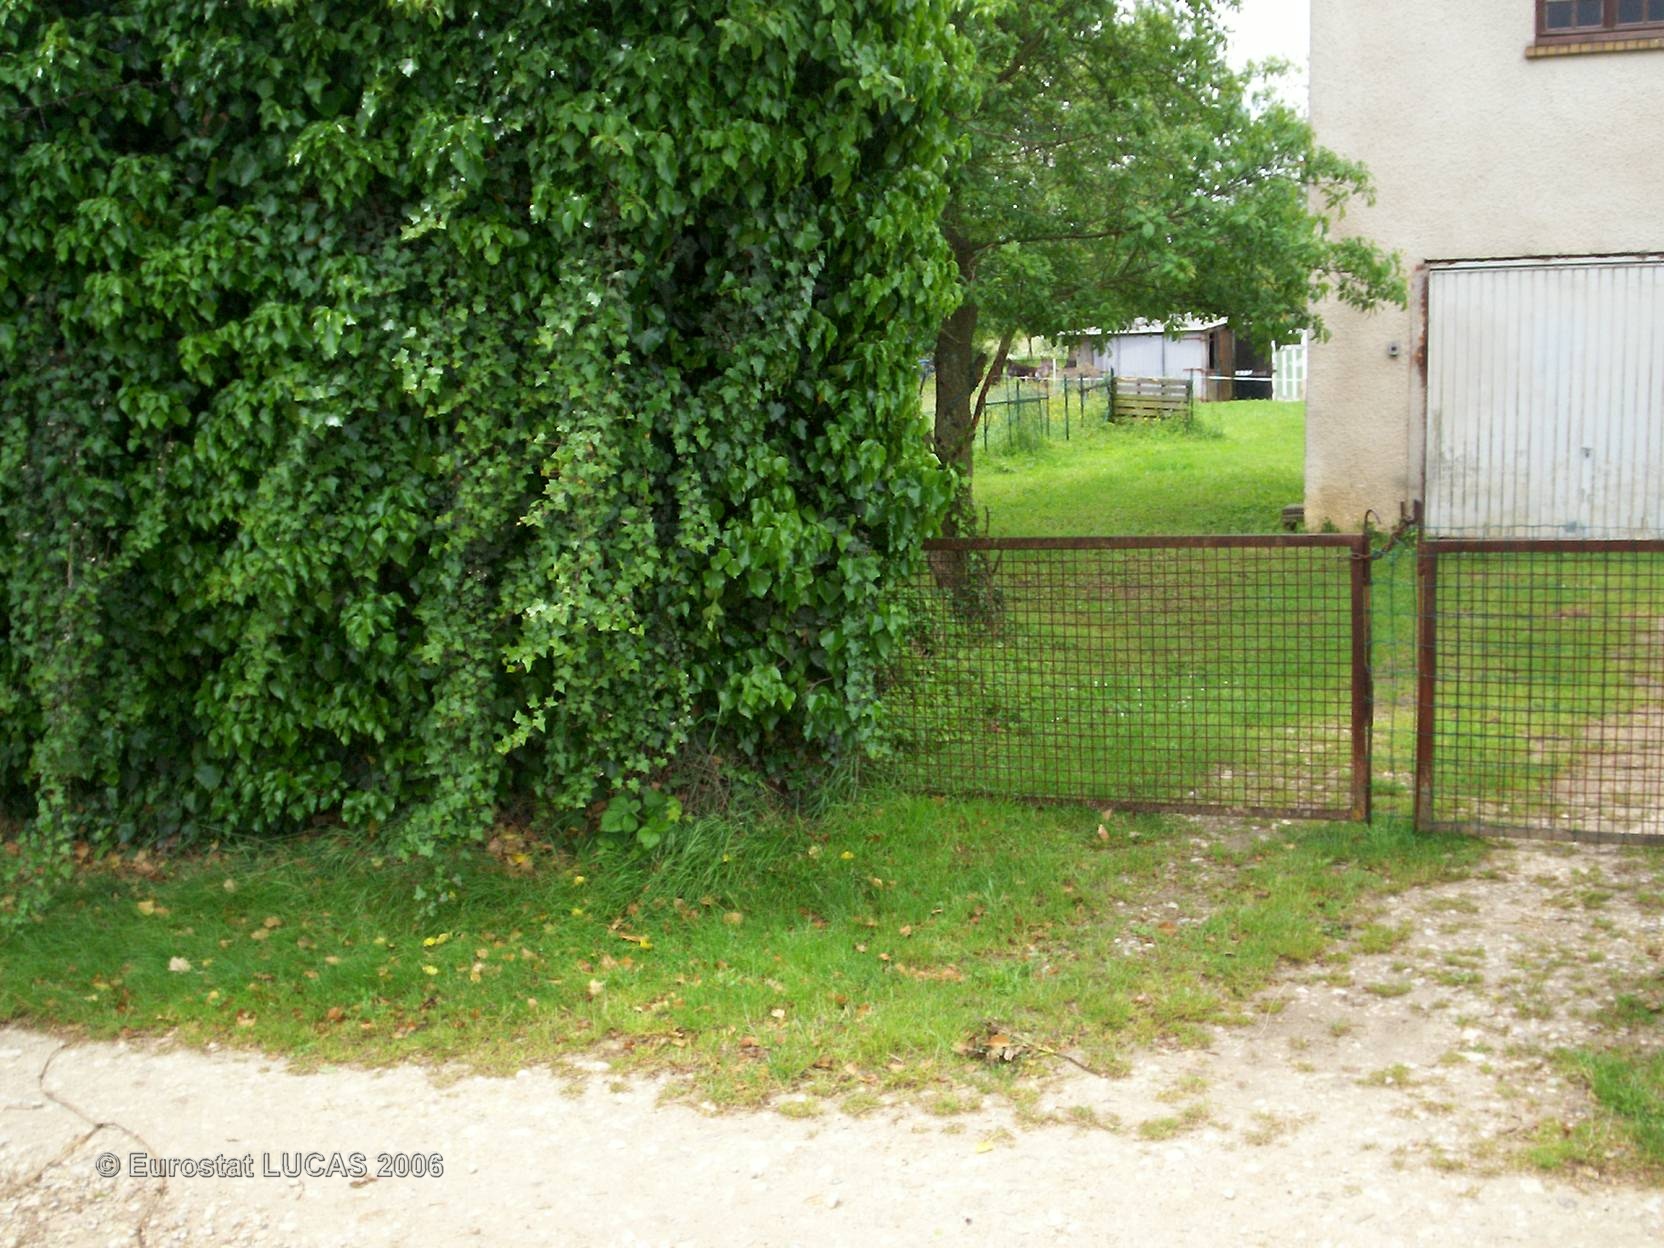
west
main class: Cropland
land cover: Rape and turnip rape
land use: Agriculture (excluding fallow land and kitchen gardens)
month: May
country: FR
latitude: 48.8948
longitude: 2.8568
